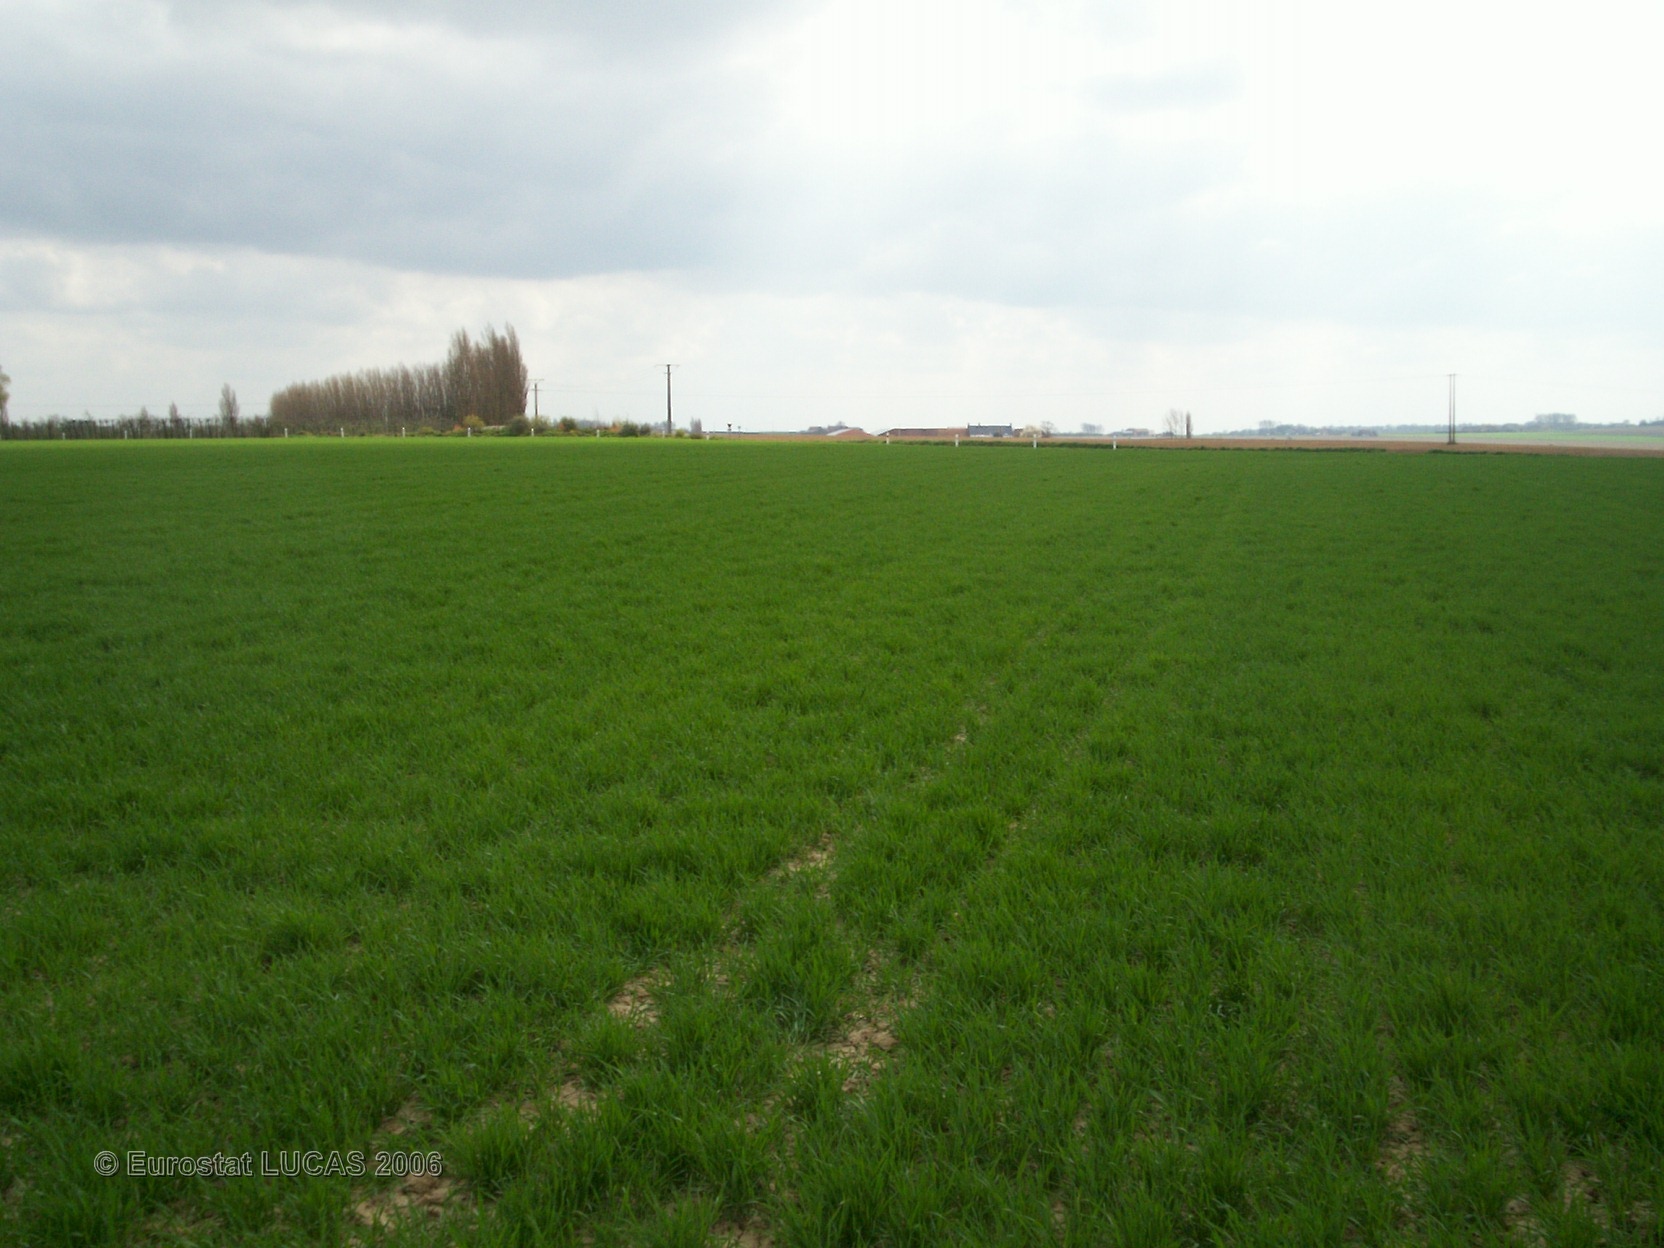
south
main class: Cropland
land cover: Common wheat
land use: Agriculture (excluding fallow land and kitchen gardens)
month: April
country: FR
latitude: 50.7632
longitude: 2.4302
